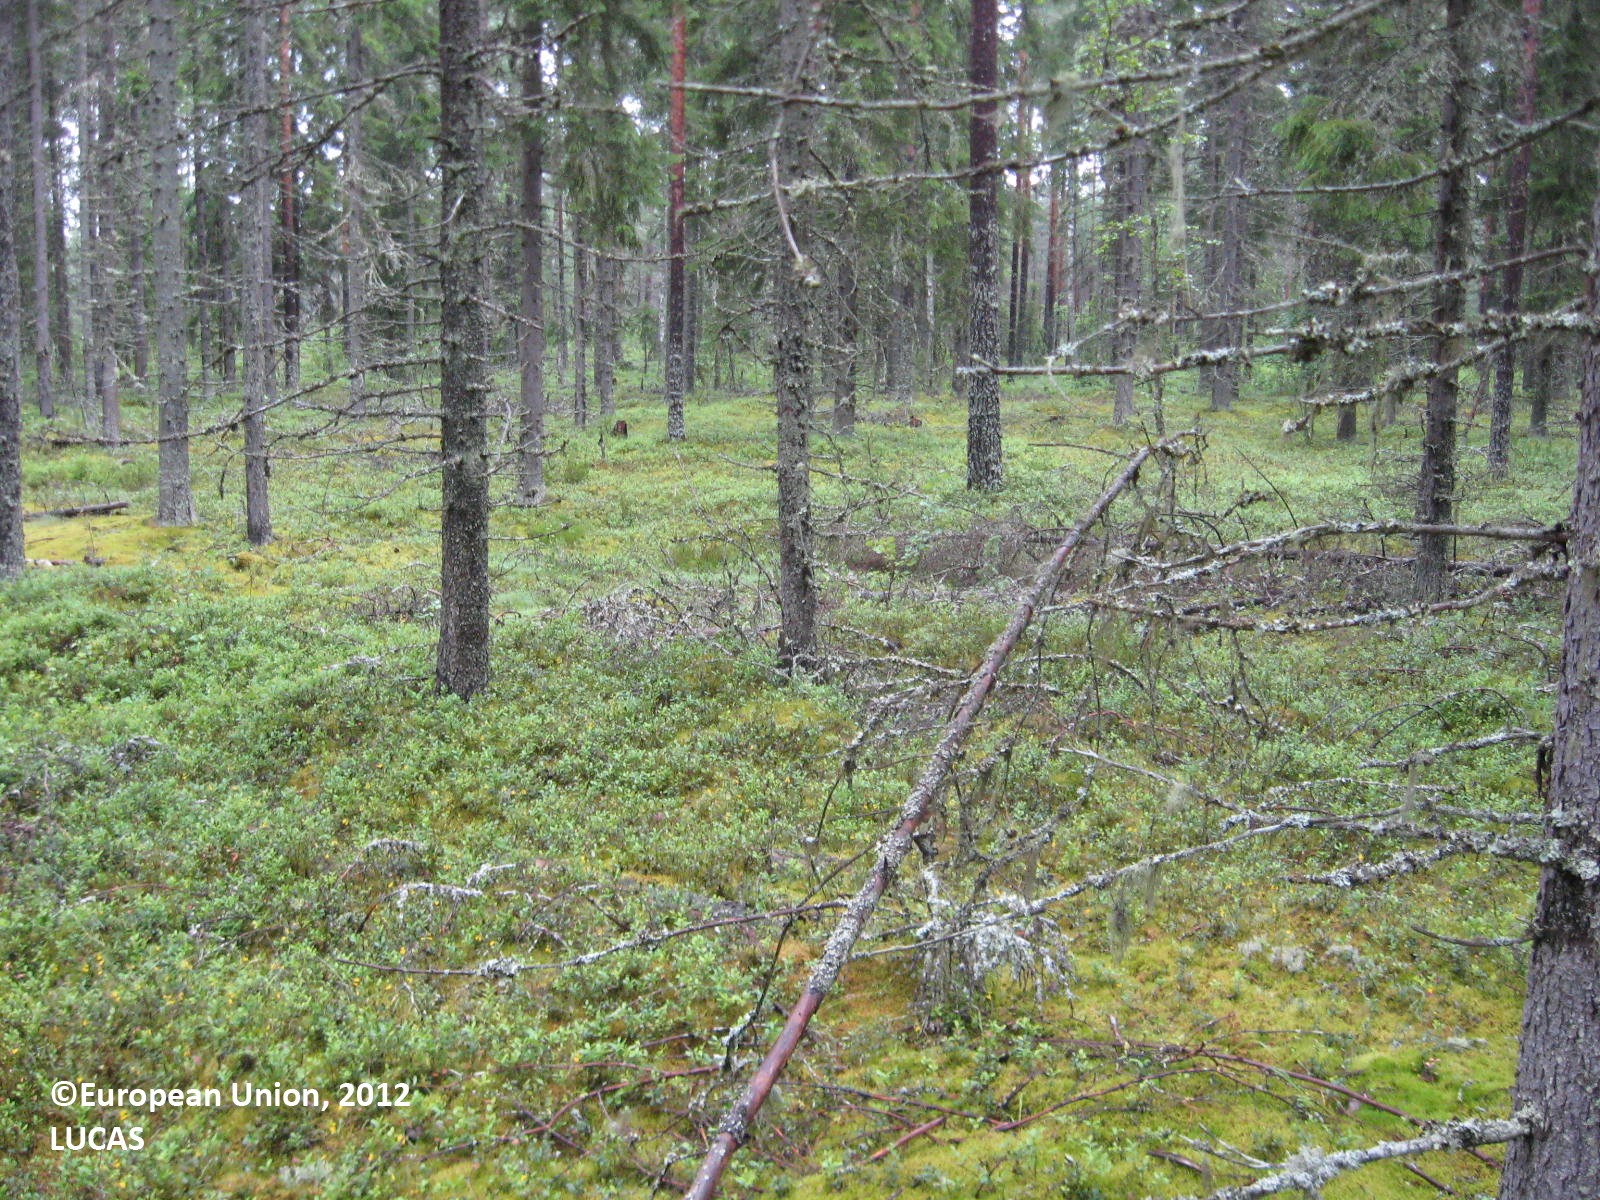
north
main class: Woodland
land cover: Spruce dominated coniferous woodland
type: boreal forest
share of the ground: > 75 %
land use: Forestry
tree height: > 5 m
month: July
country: FI
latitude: 62.4099
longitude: 22.3835
